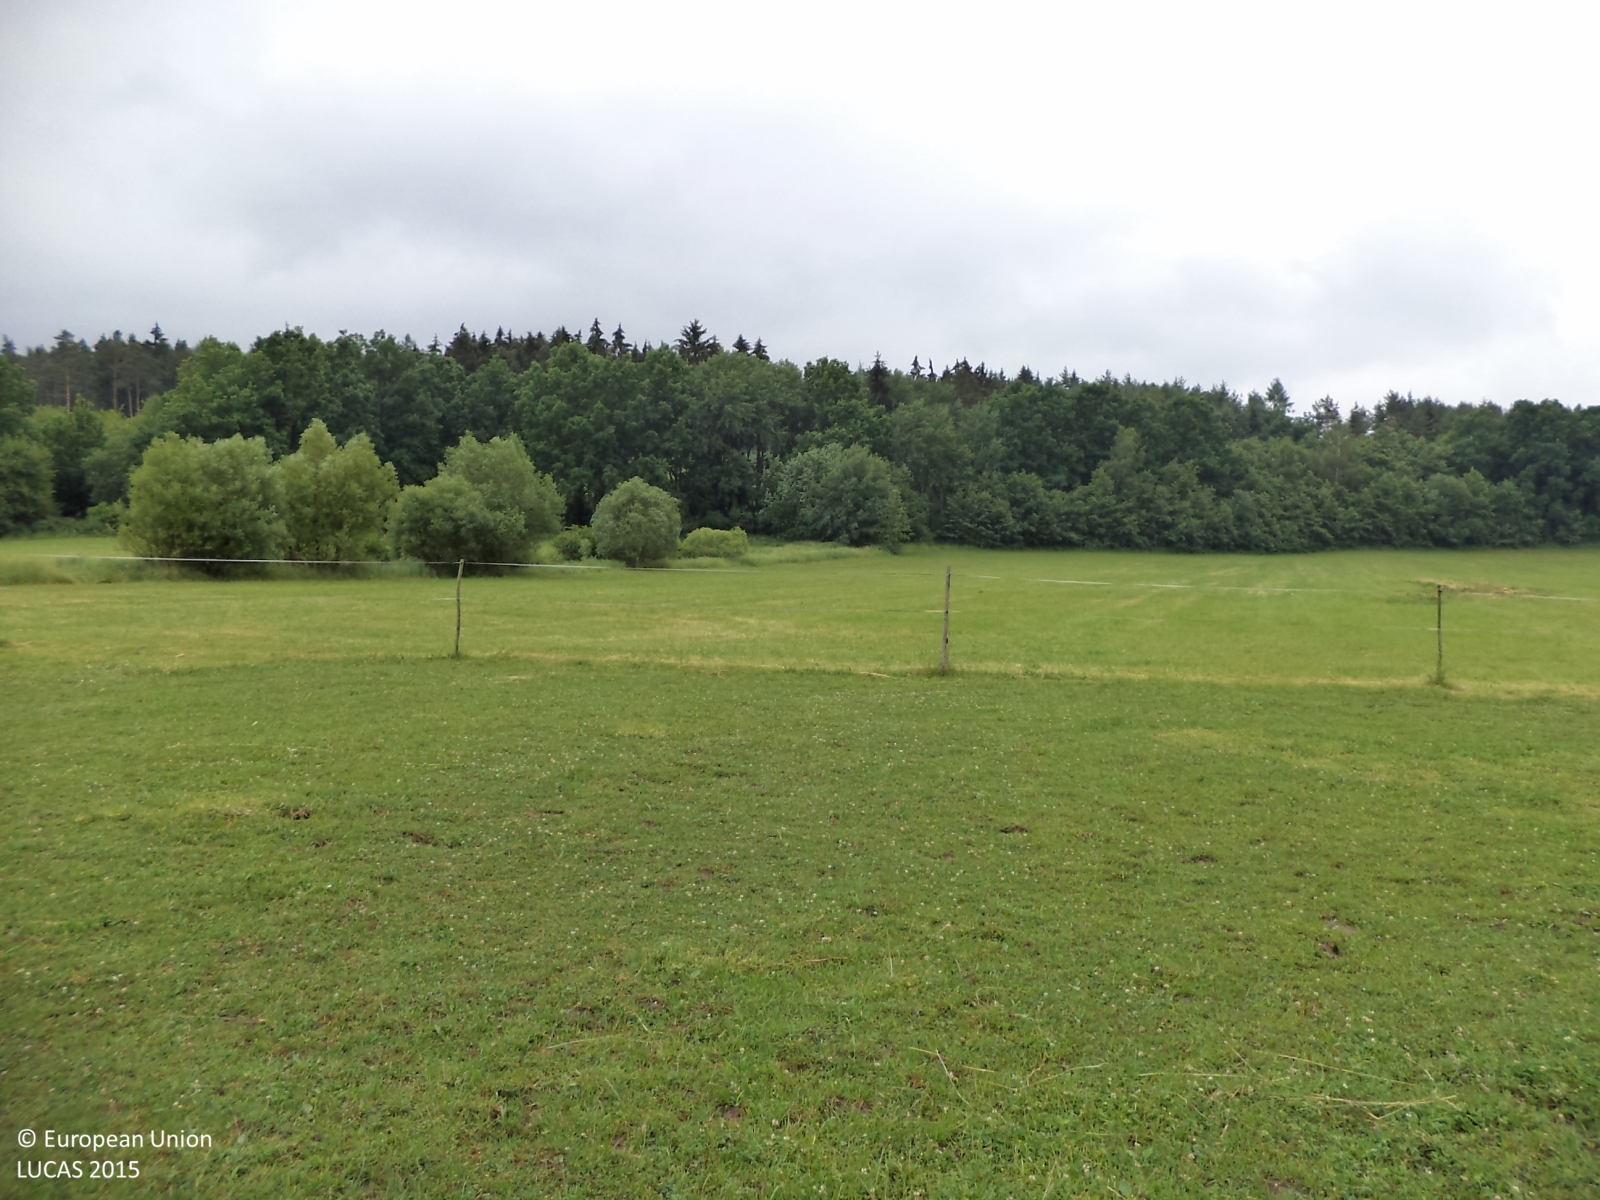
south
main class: Grassland
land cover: Grassland without tree/shrub cover
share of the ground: > 75 %
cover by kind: herbaceous plants 100 %
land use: Agriculture (excluding fallow land and kitchen gardens)
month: June
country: CZ
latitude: 49.2165
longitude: 14.4080
